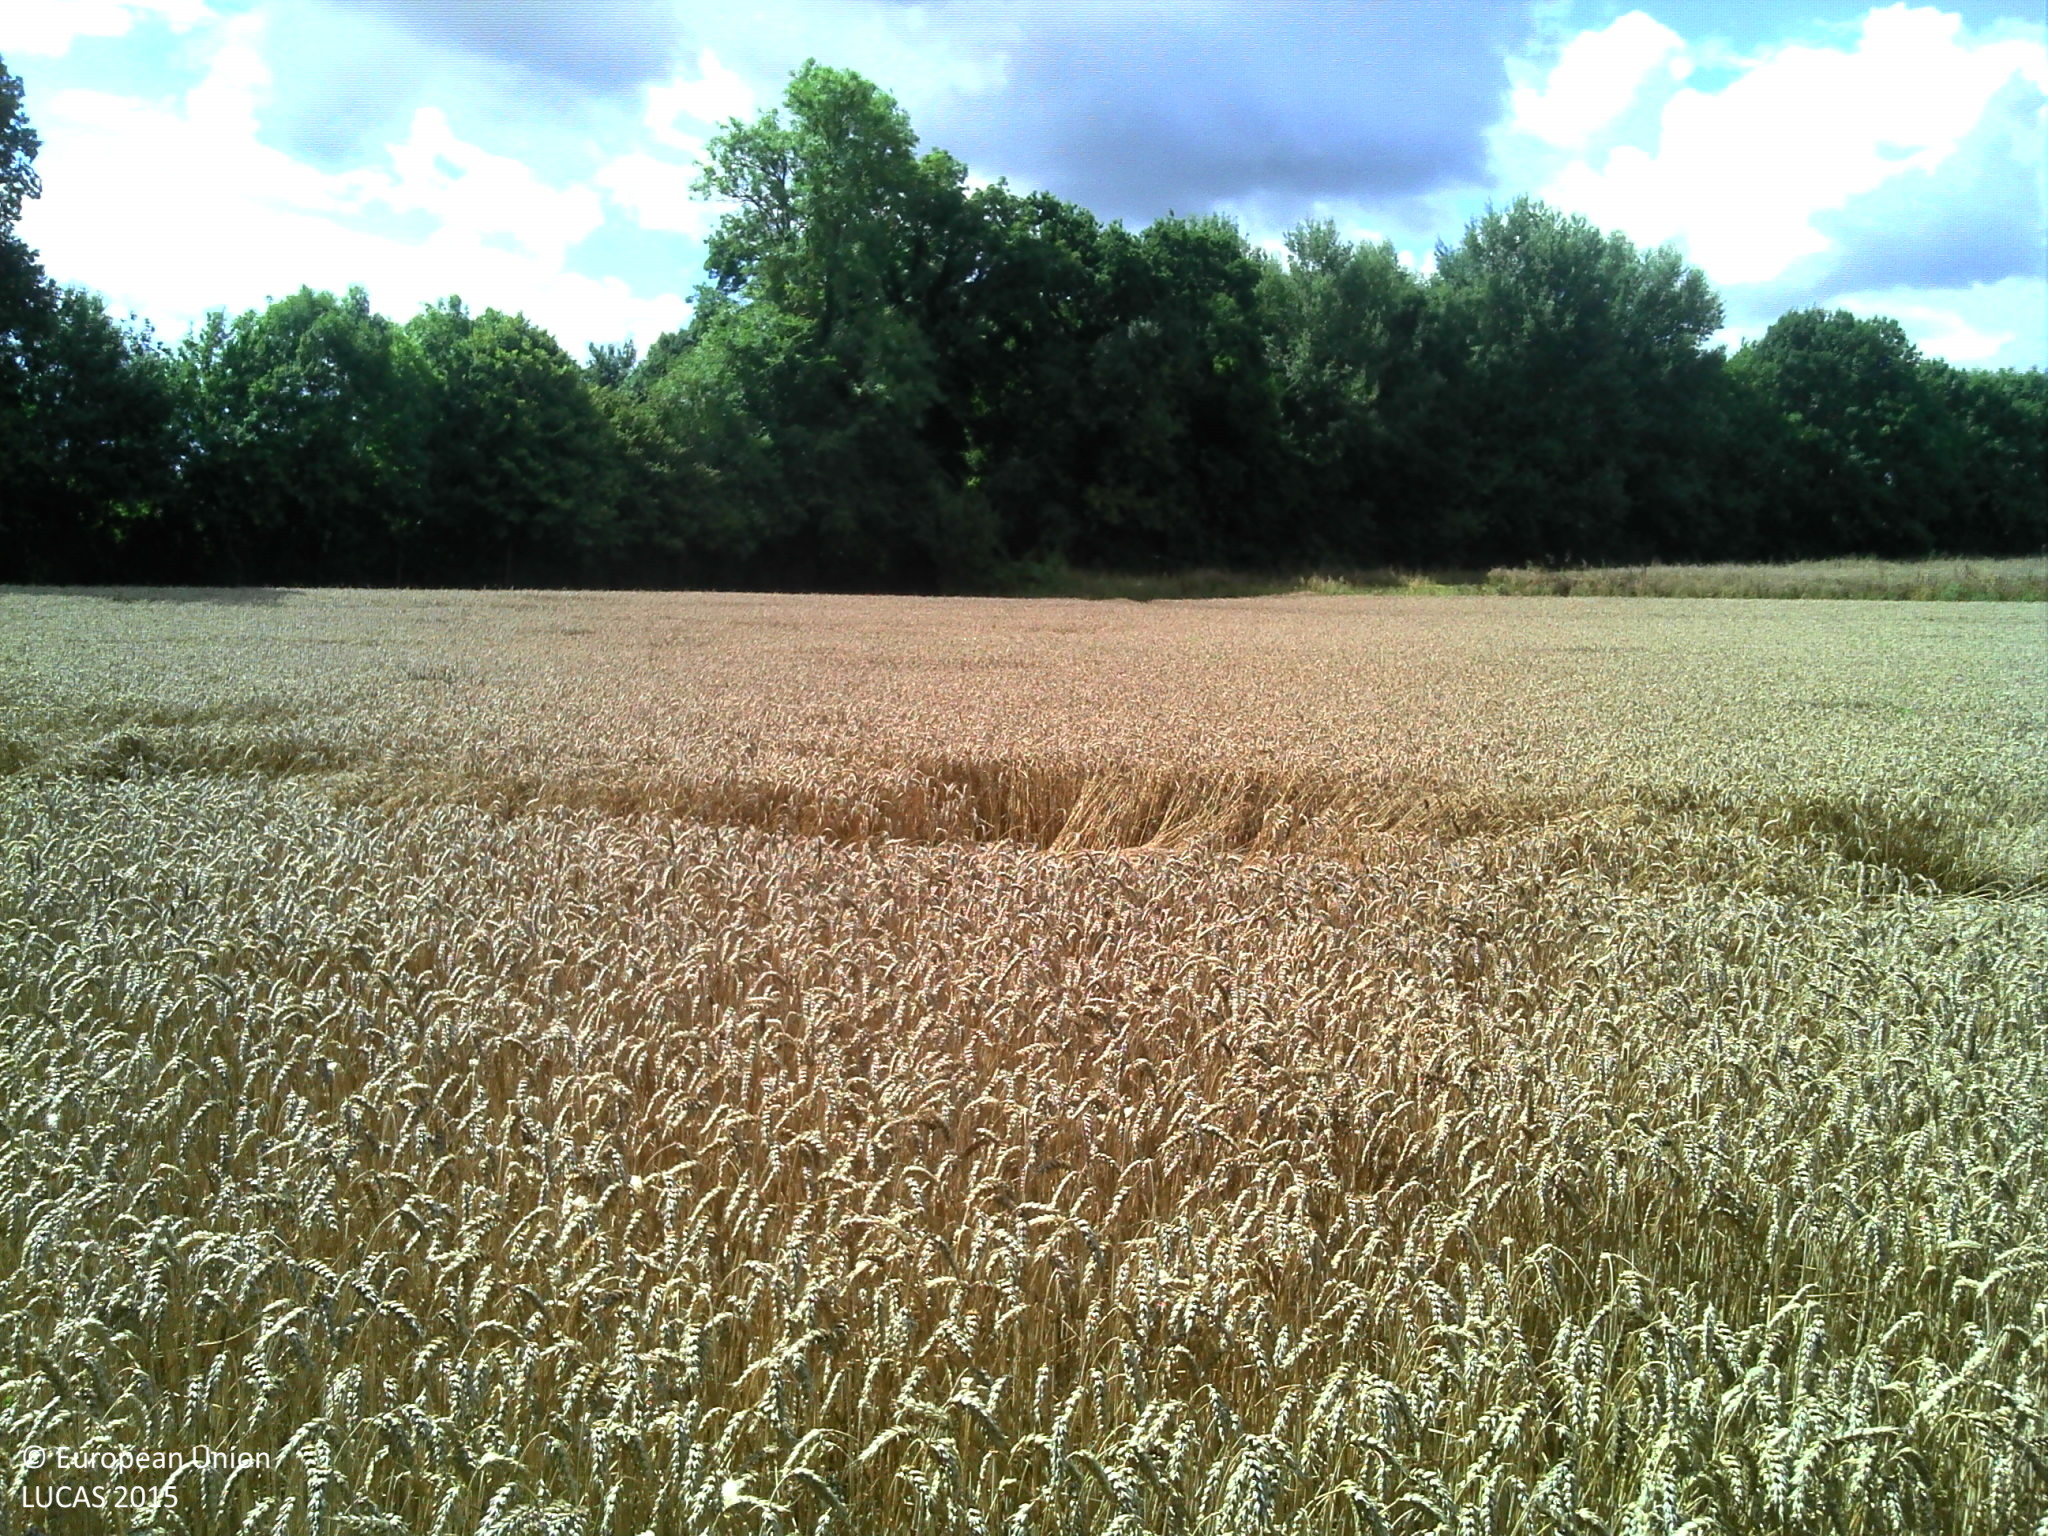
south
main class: Woodland
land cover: Broadleaved woodland
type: mesophytic deciduous forest
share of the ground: > 75 %
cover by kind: broadleaved forest trees 90 %, herbaceous plants 10 %
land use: Semi-natural and natural areas not in use
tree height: < 5 m
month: July
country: FR
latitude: 48.9125
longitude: -0.1705
